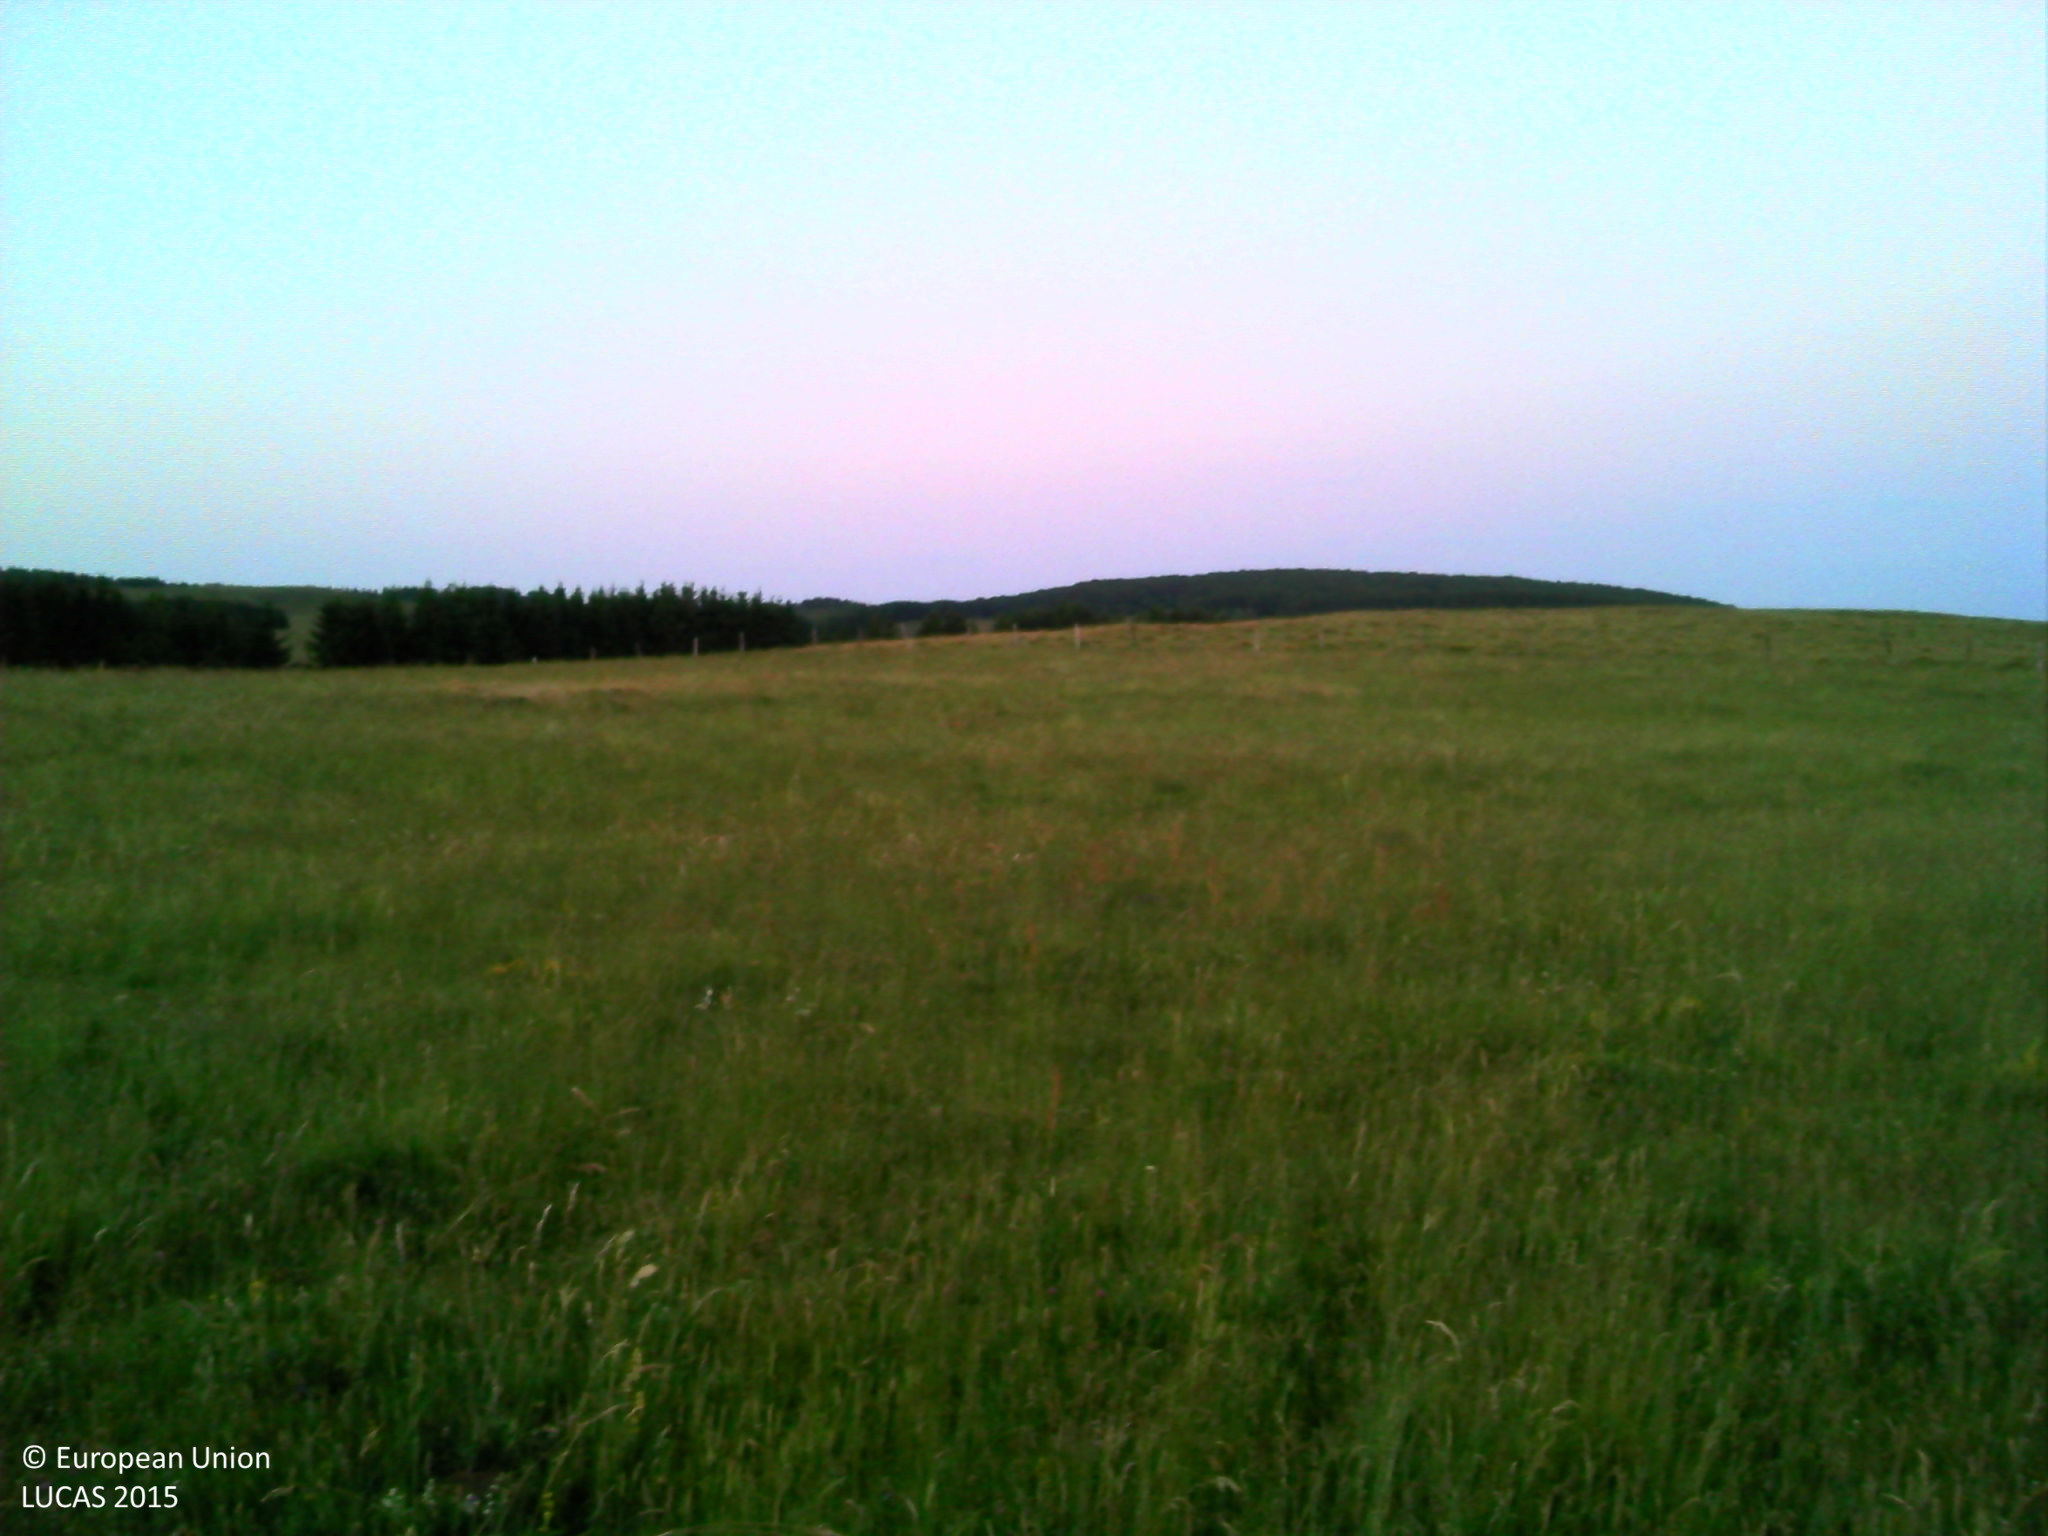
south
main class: Grassland
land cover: Grassland without tree/shrub cover
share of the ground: > 75 %
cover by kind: herbaceous plants 100 %
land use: Agriculture (excluding fallow land and kitchen gardens)
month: July
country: FR
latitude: 44.6914
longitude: 2.9748
